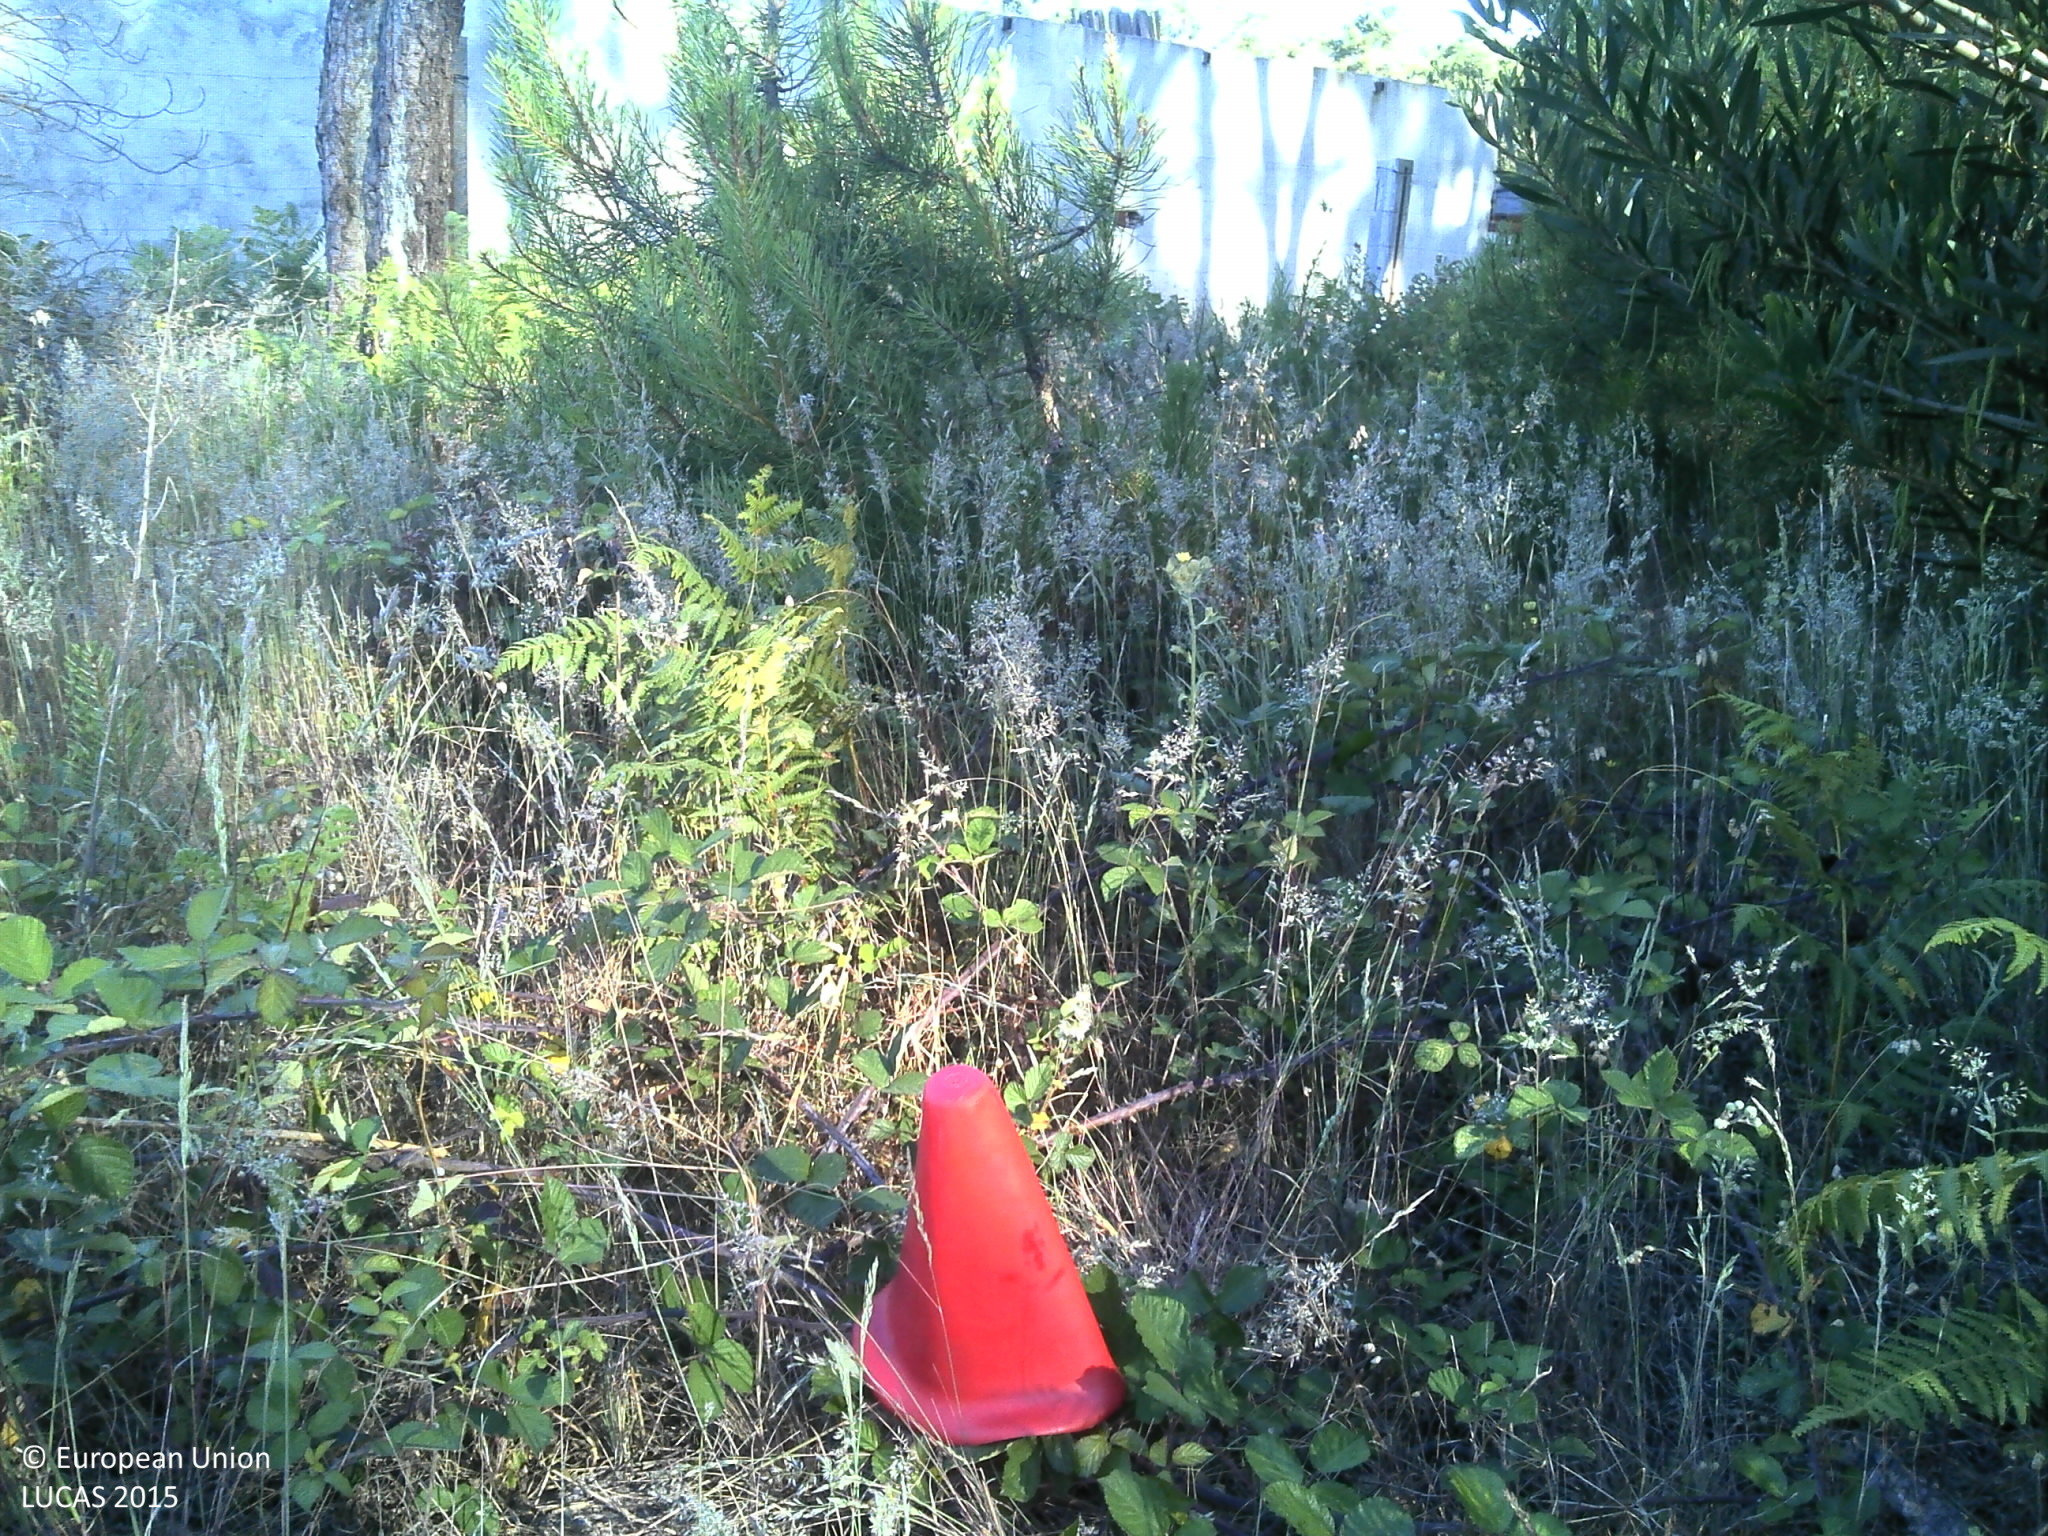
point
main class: Woodland
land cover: Pine dominated coniferous woodland
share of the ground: 25 - 50 %
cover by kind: coniferous forest trees 50 %, shrubs 30 %, herbaceous plants 10 %, consolidated bare surface 5 %, unconsolidated bare surface 5 %
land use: Forestry
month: May
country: PT
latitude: 40.4782
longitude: -8.6497
